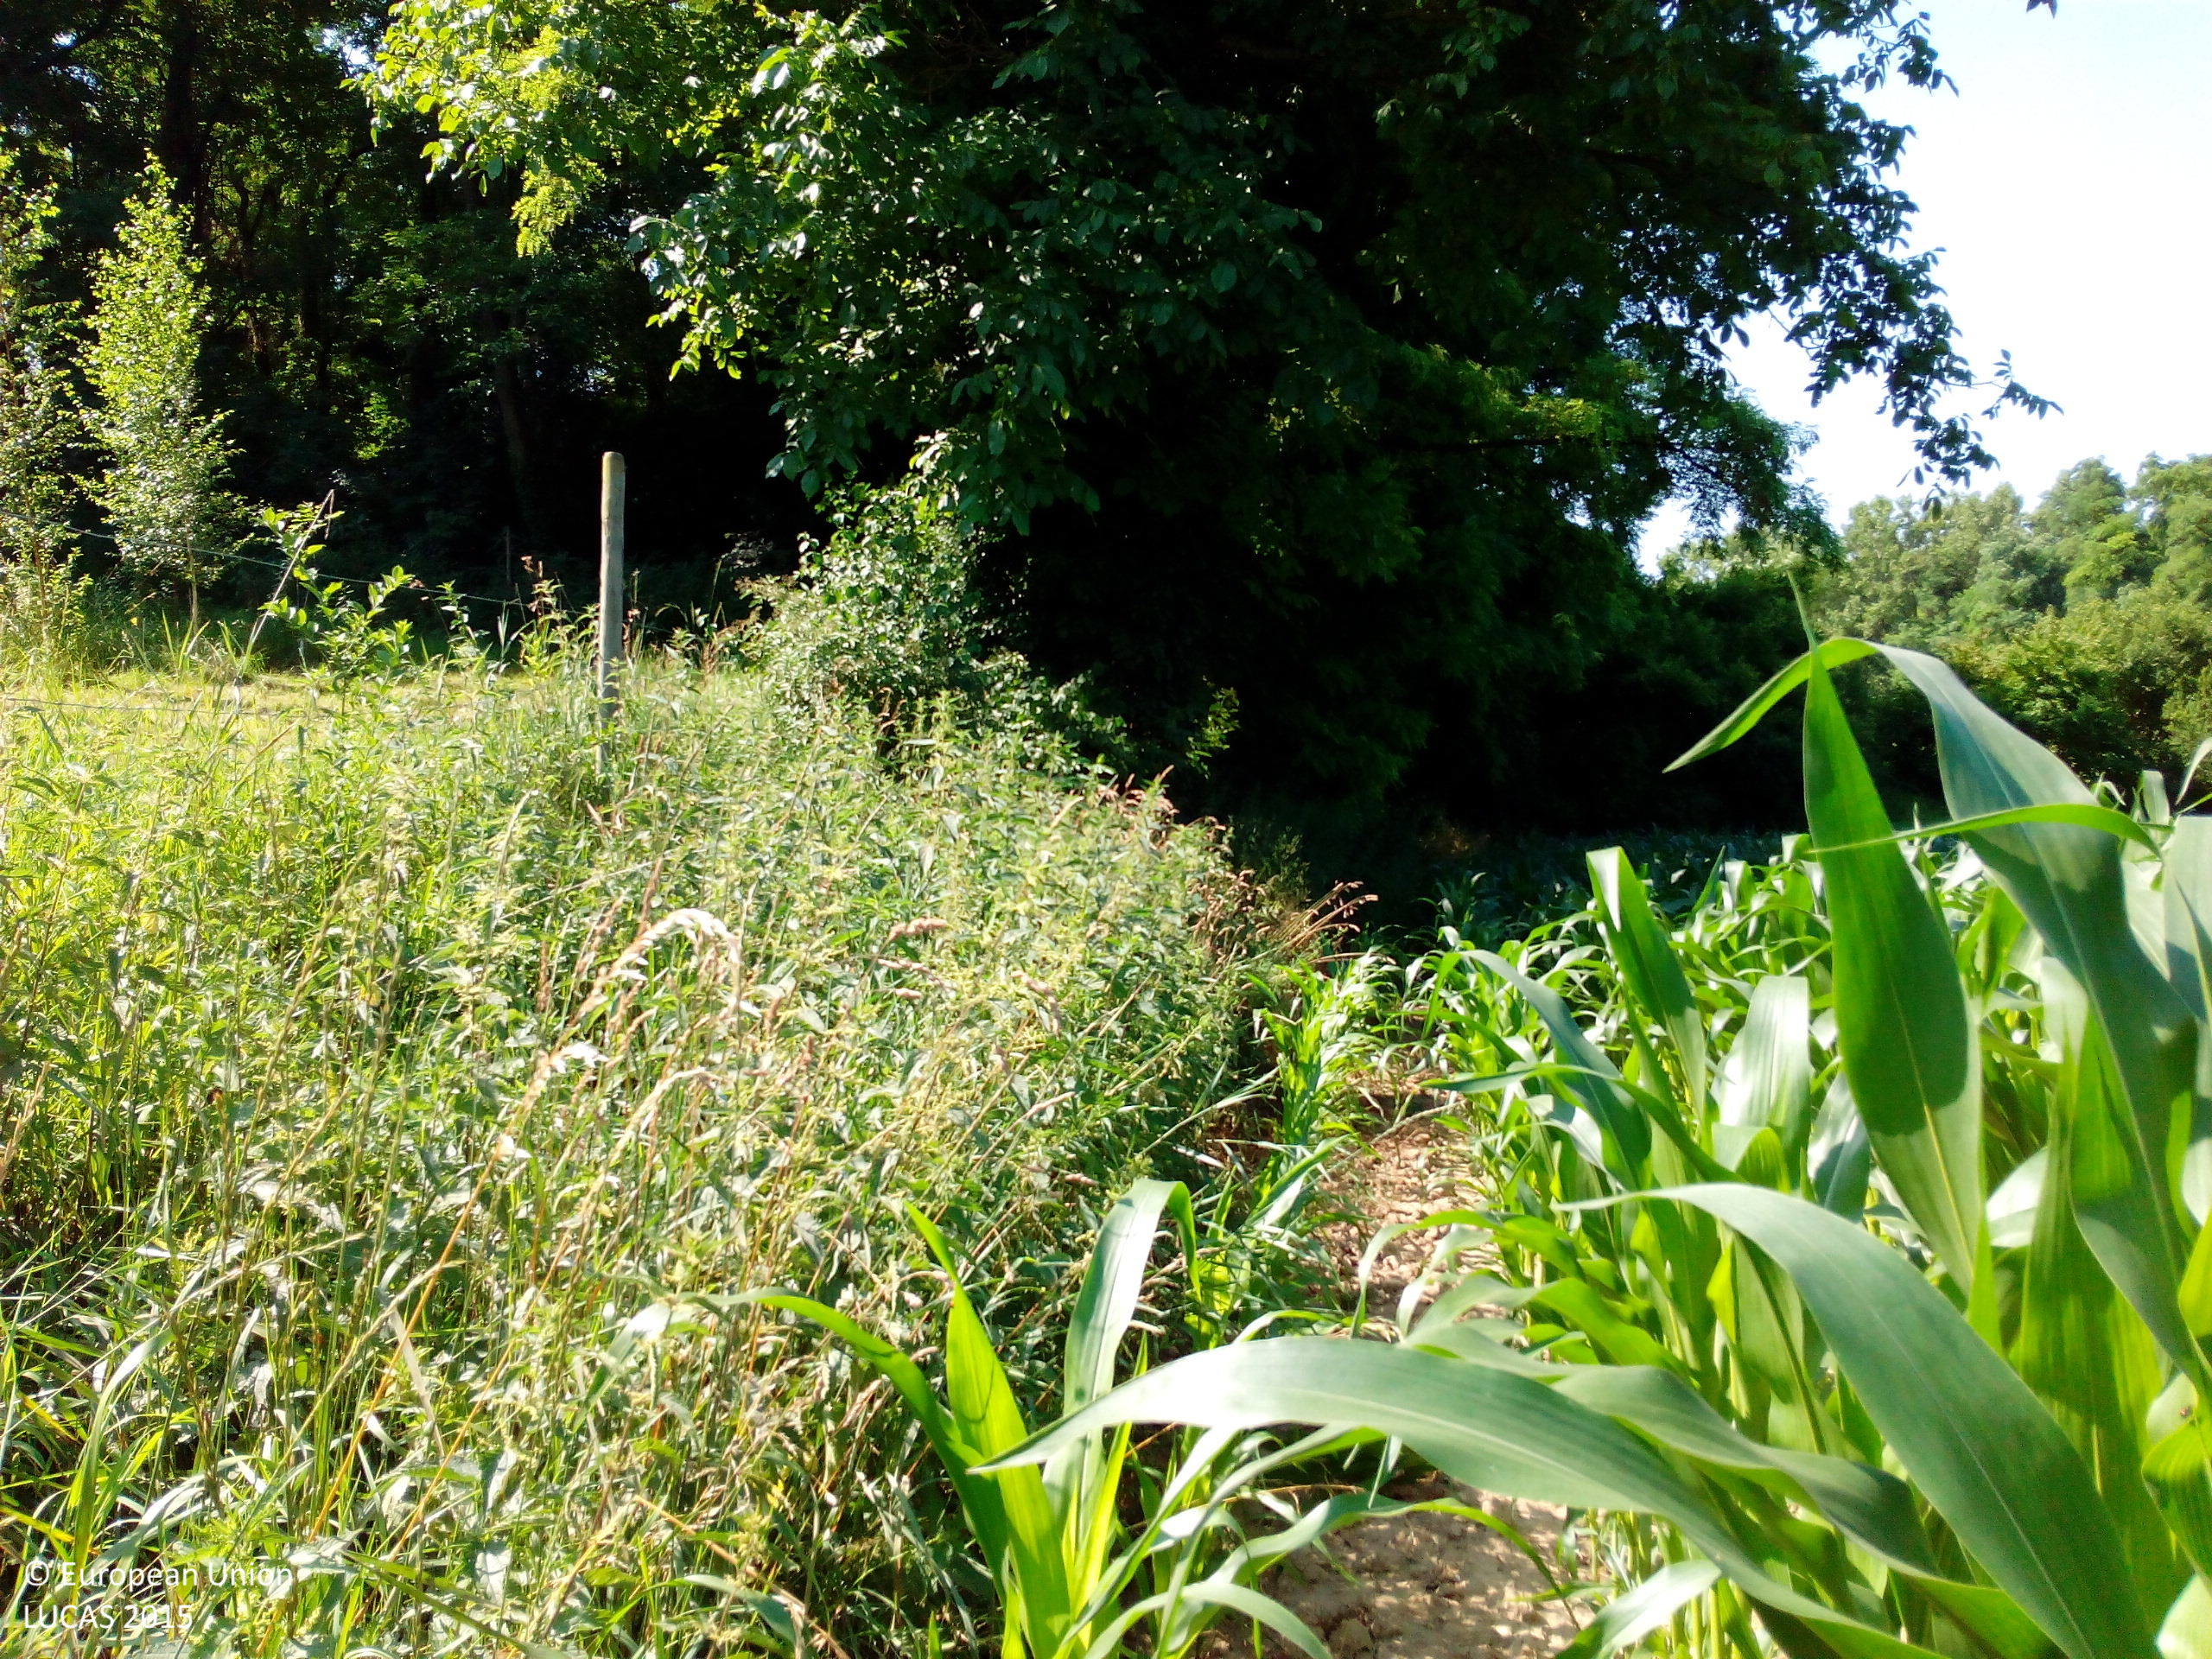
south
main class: Cropland
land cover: Maize
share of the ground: > 75 %
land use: Agriculture (excluding fallow land and kitchen gardens)
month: July
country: DE
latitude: 47.8381
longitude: 7.6364
